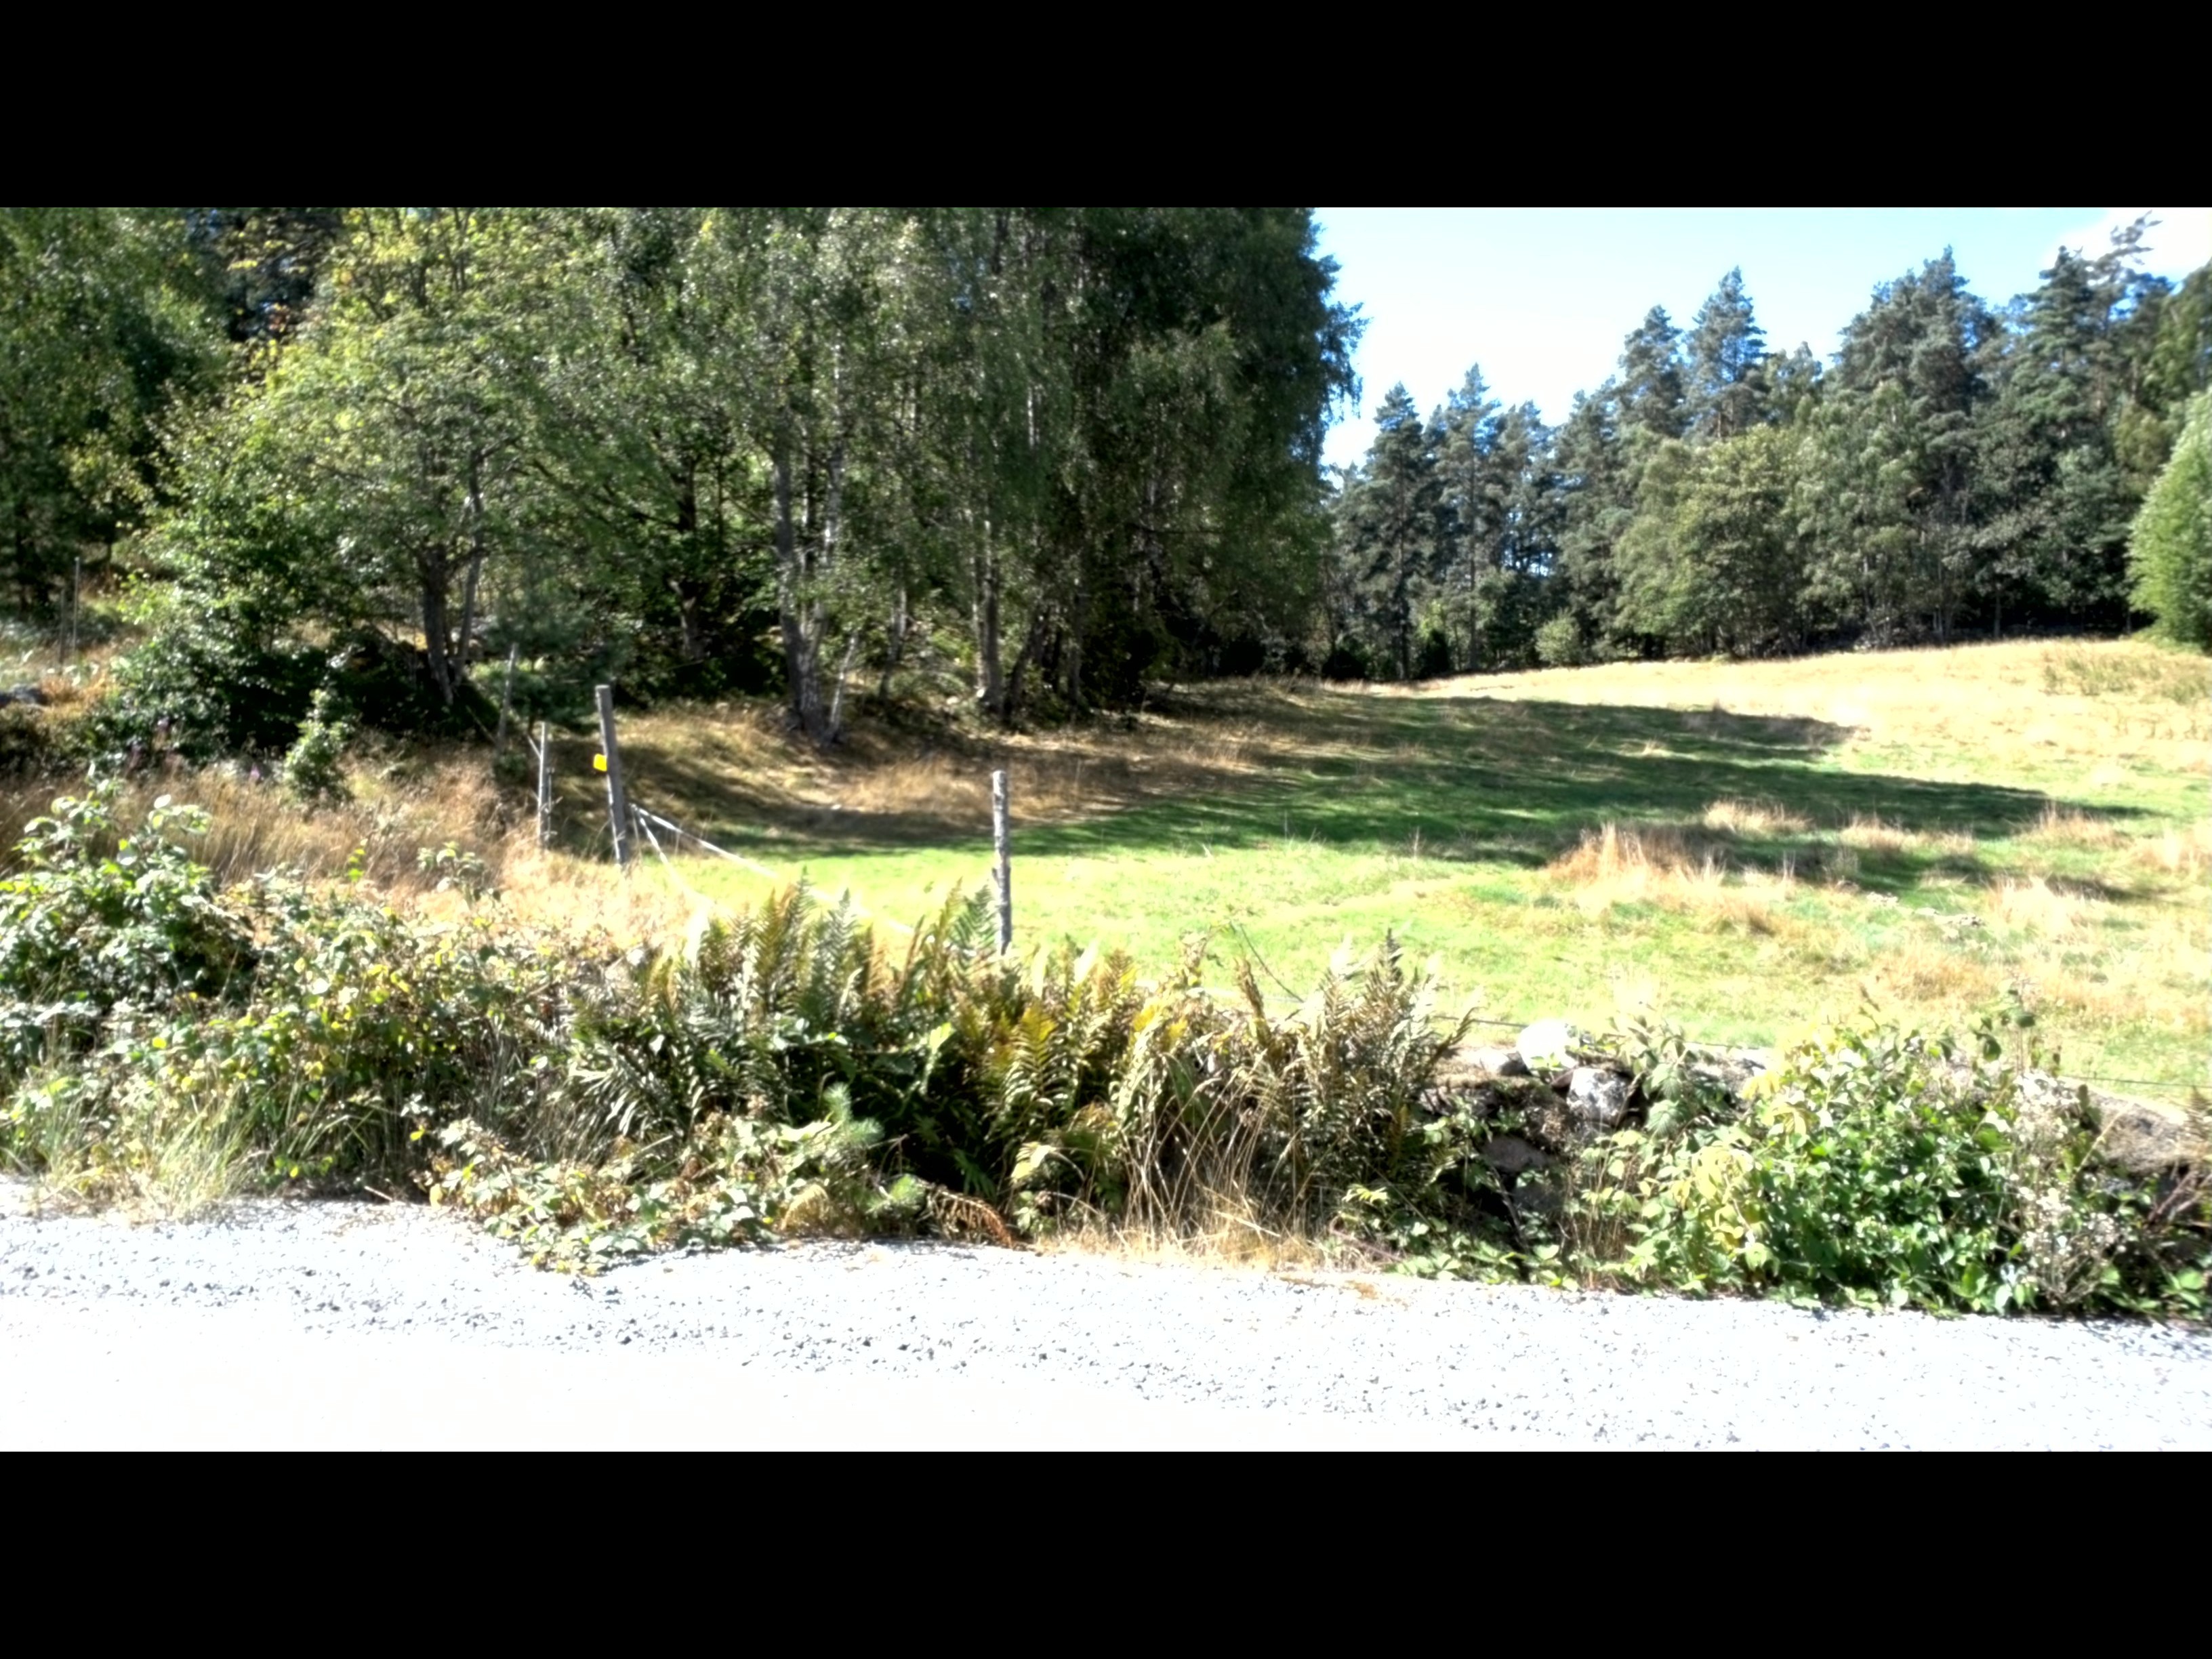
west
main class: Grassland
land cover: Grassland without tree/shrub cover
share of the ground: > 75 %
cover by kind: herbaceous plants 100 %
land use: Residential
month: August
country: SE
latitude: 56.2425
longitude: 14.7907
